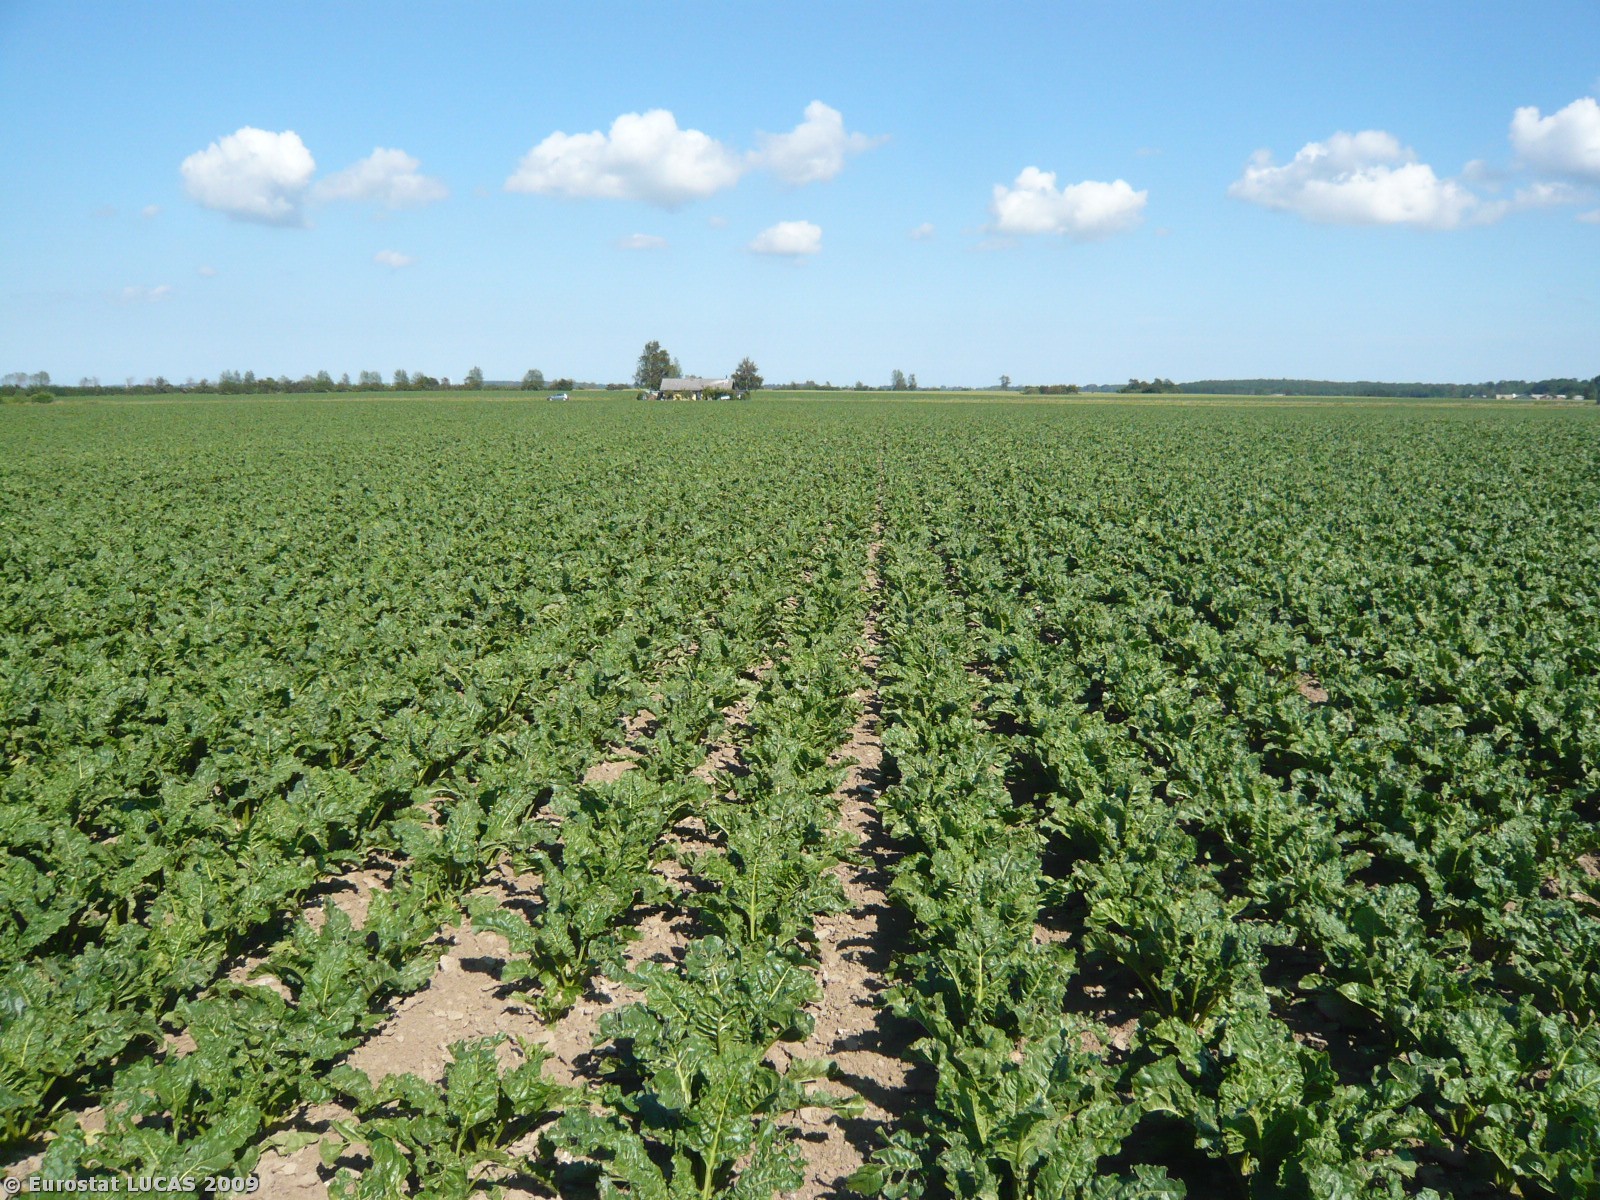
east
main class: Cropland
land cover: Sugar beet
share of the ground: > 75 %
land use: Agriculture (excluding fallow land and kitchen gardens)
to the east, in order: Sugar beet
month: June
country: DK
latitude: 54.8825
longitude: 11.6667
